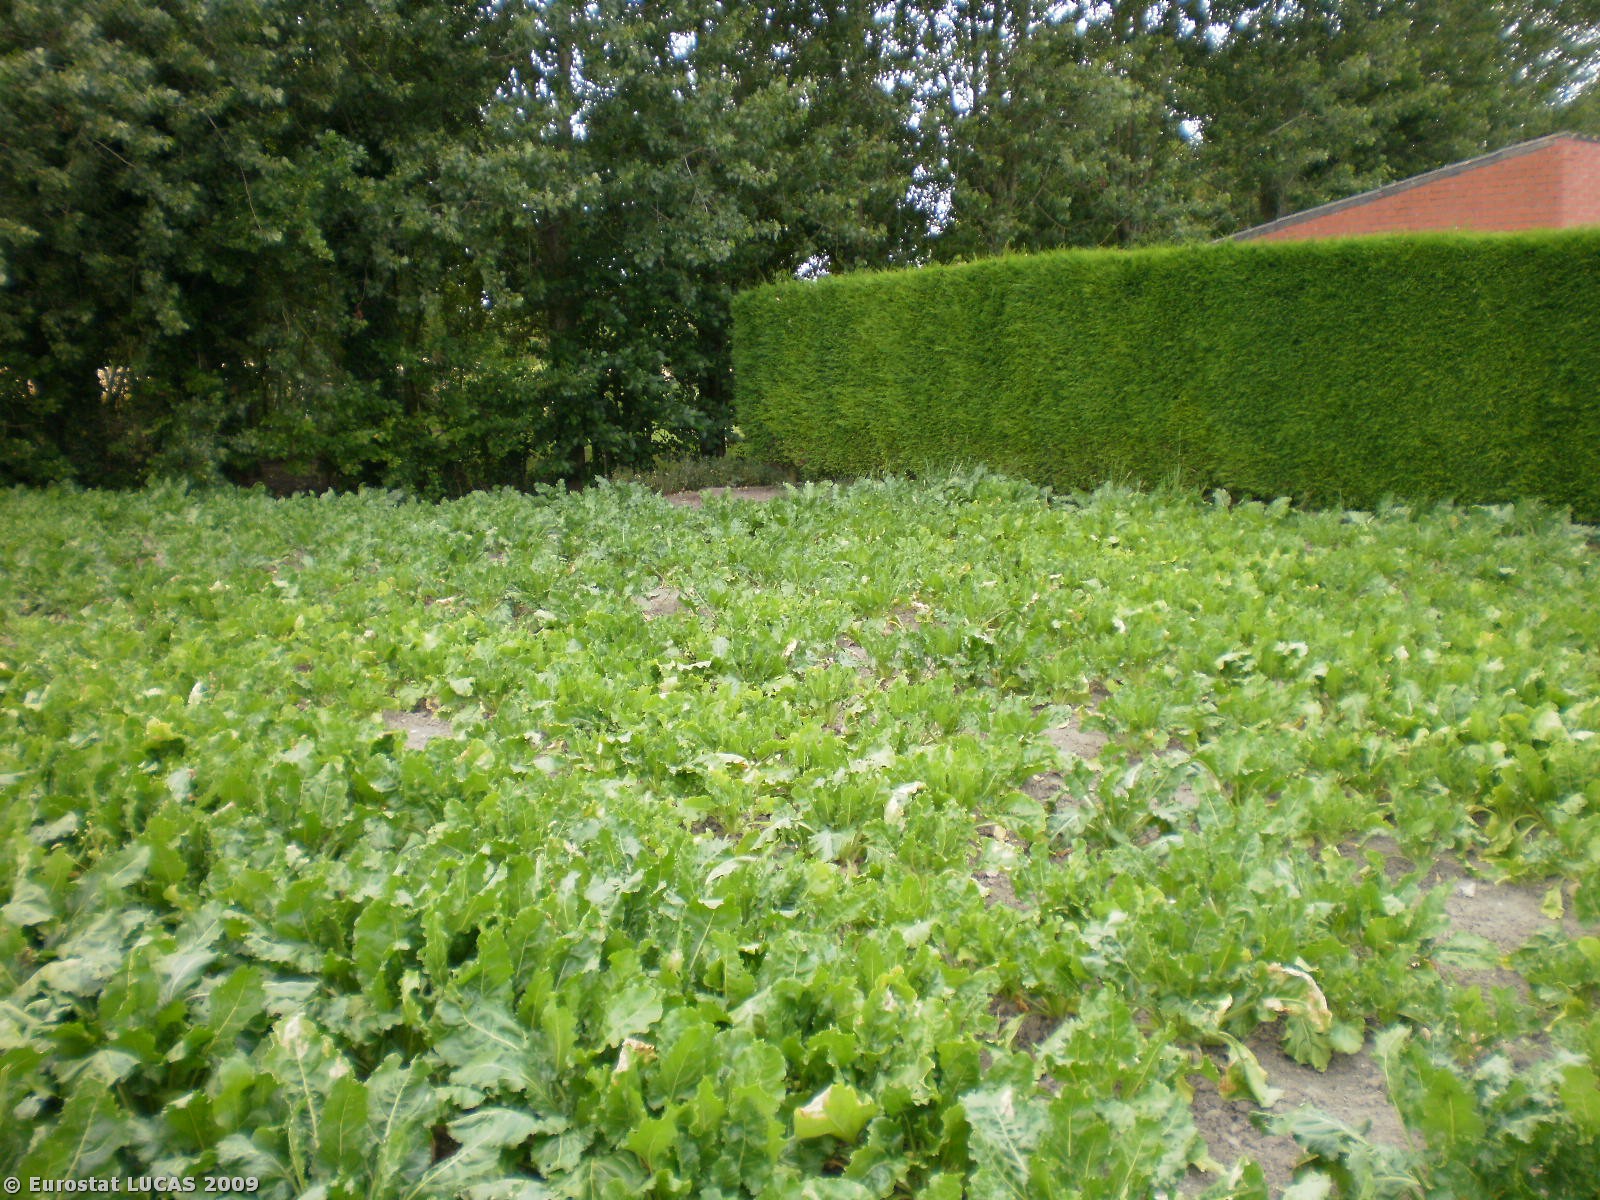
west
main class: Cropland
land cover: Sugar beet
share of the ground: 50 - 75 %
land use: Agriculture (excluding fallow land and kitchen gardens)
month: July
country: BE
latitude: 51.1103
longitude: 2.7754
